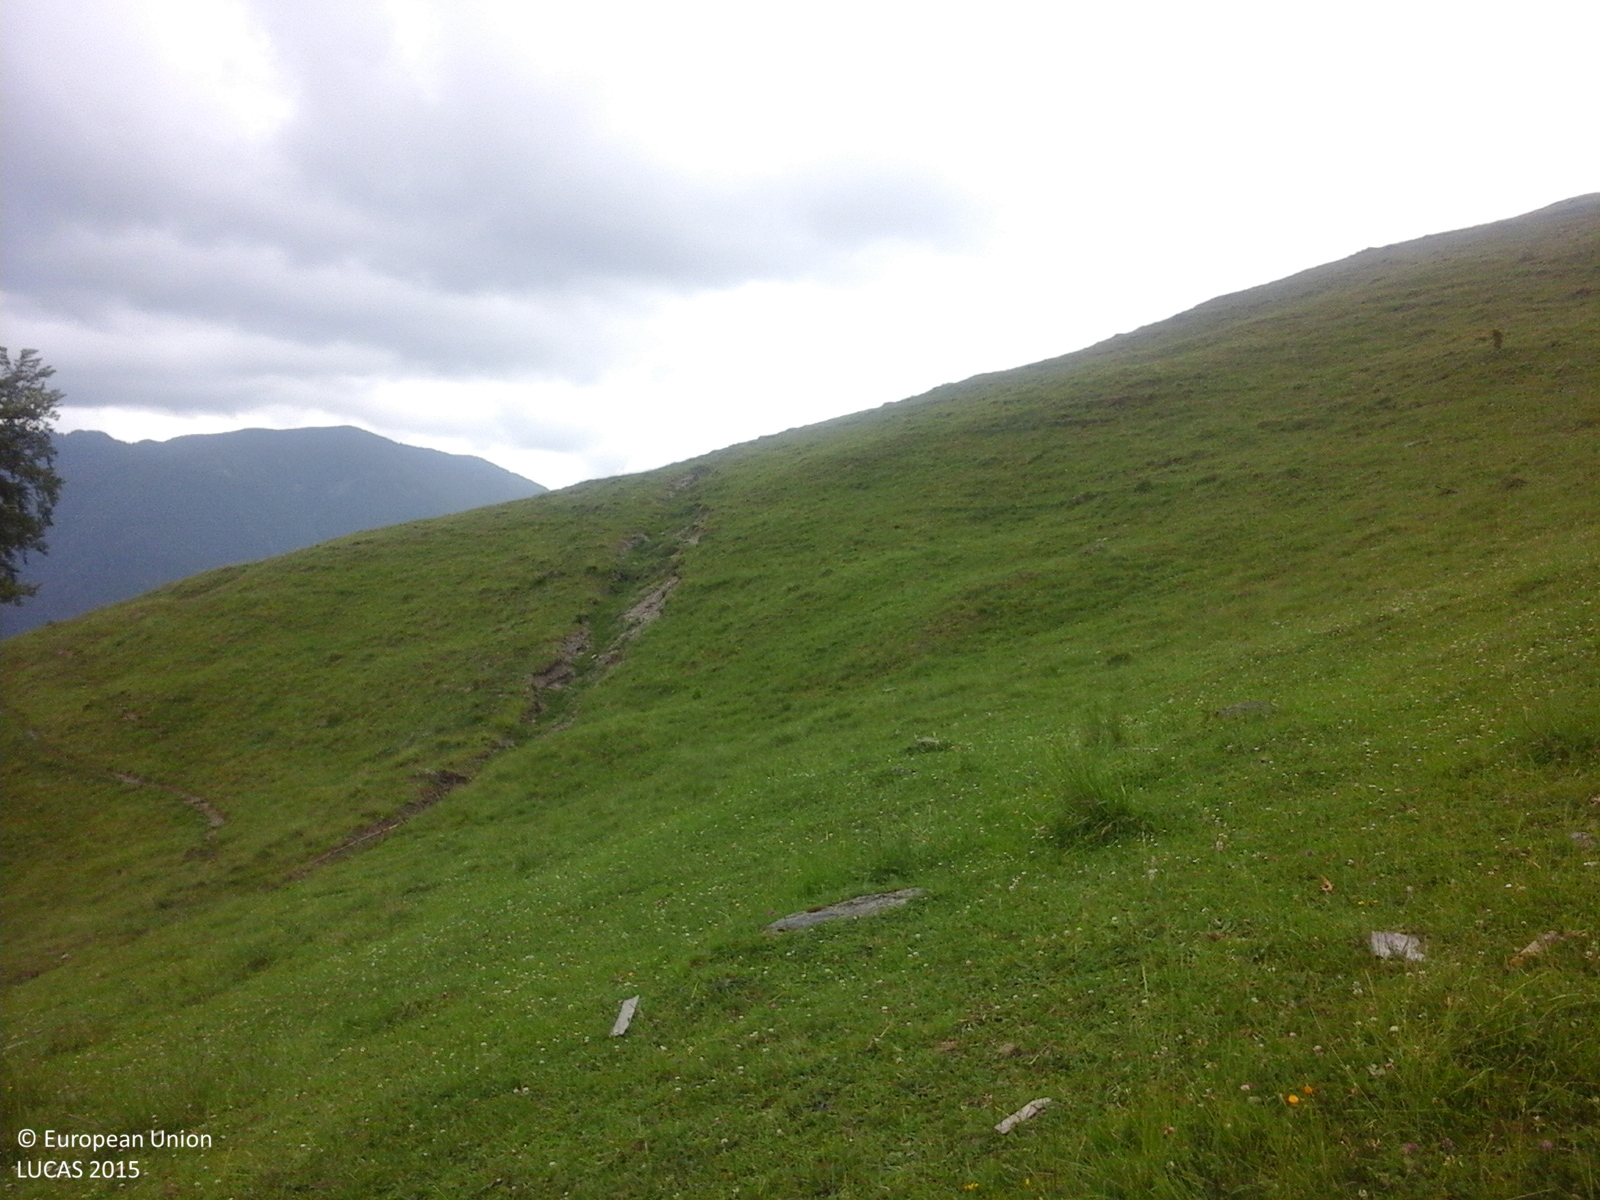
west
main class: Grassland
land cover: Grassland without tree/shrub cover
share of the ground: > 75 %
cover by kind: herbaceous plants 100 %
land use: Agriculture (excluding fallow land and kitchen gardens)
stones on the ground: 10 - 25 %
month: June
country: RO
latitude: 47.3323
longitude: 25.6681
